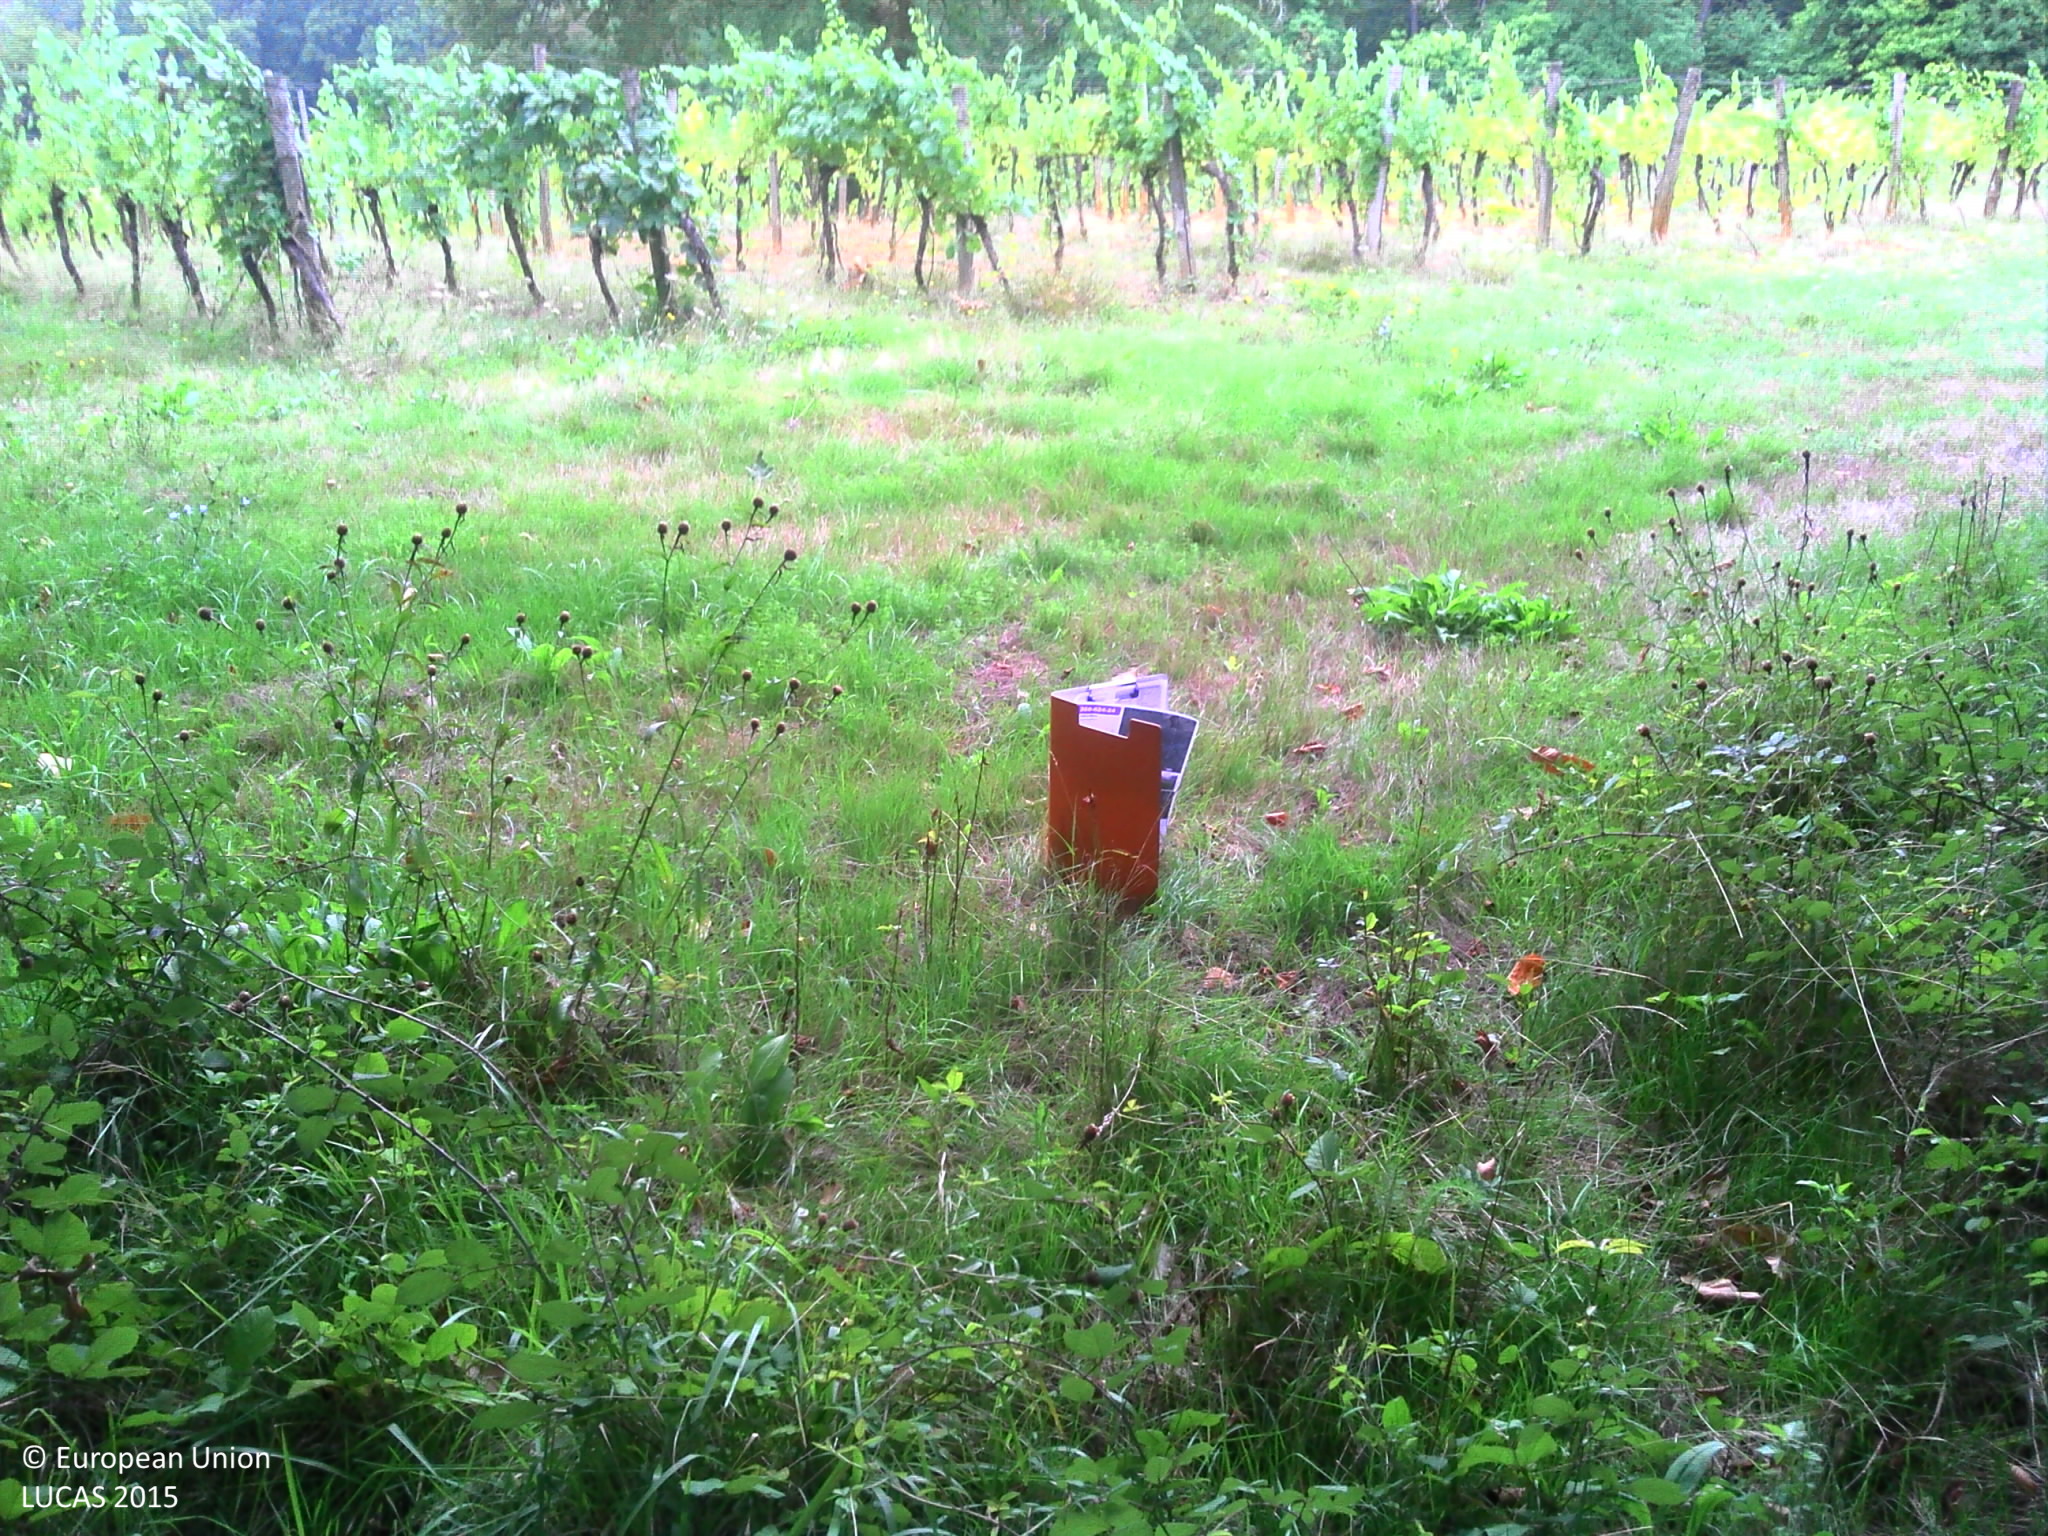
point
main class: Grassland
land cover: Grassland without tree/shrub cover
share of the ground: > 75 %
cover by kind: herbaceous plants 100 %
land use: Agriculture (excluding fallow land and kitchen gardens)
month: August
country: FR
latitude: 44.5389
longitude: 0.9967
